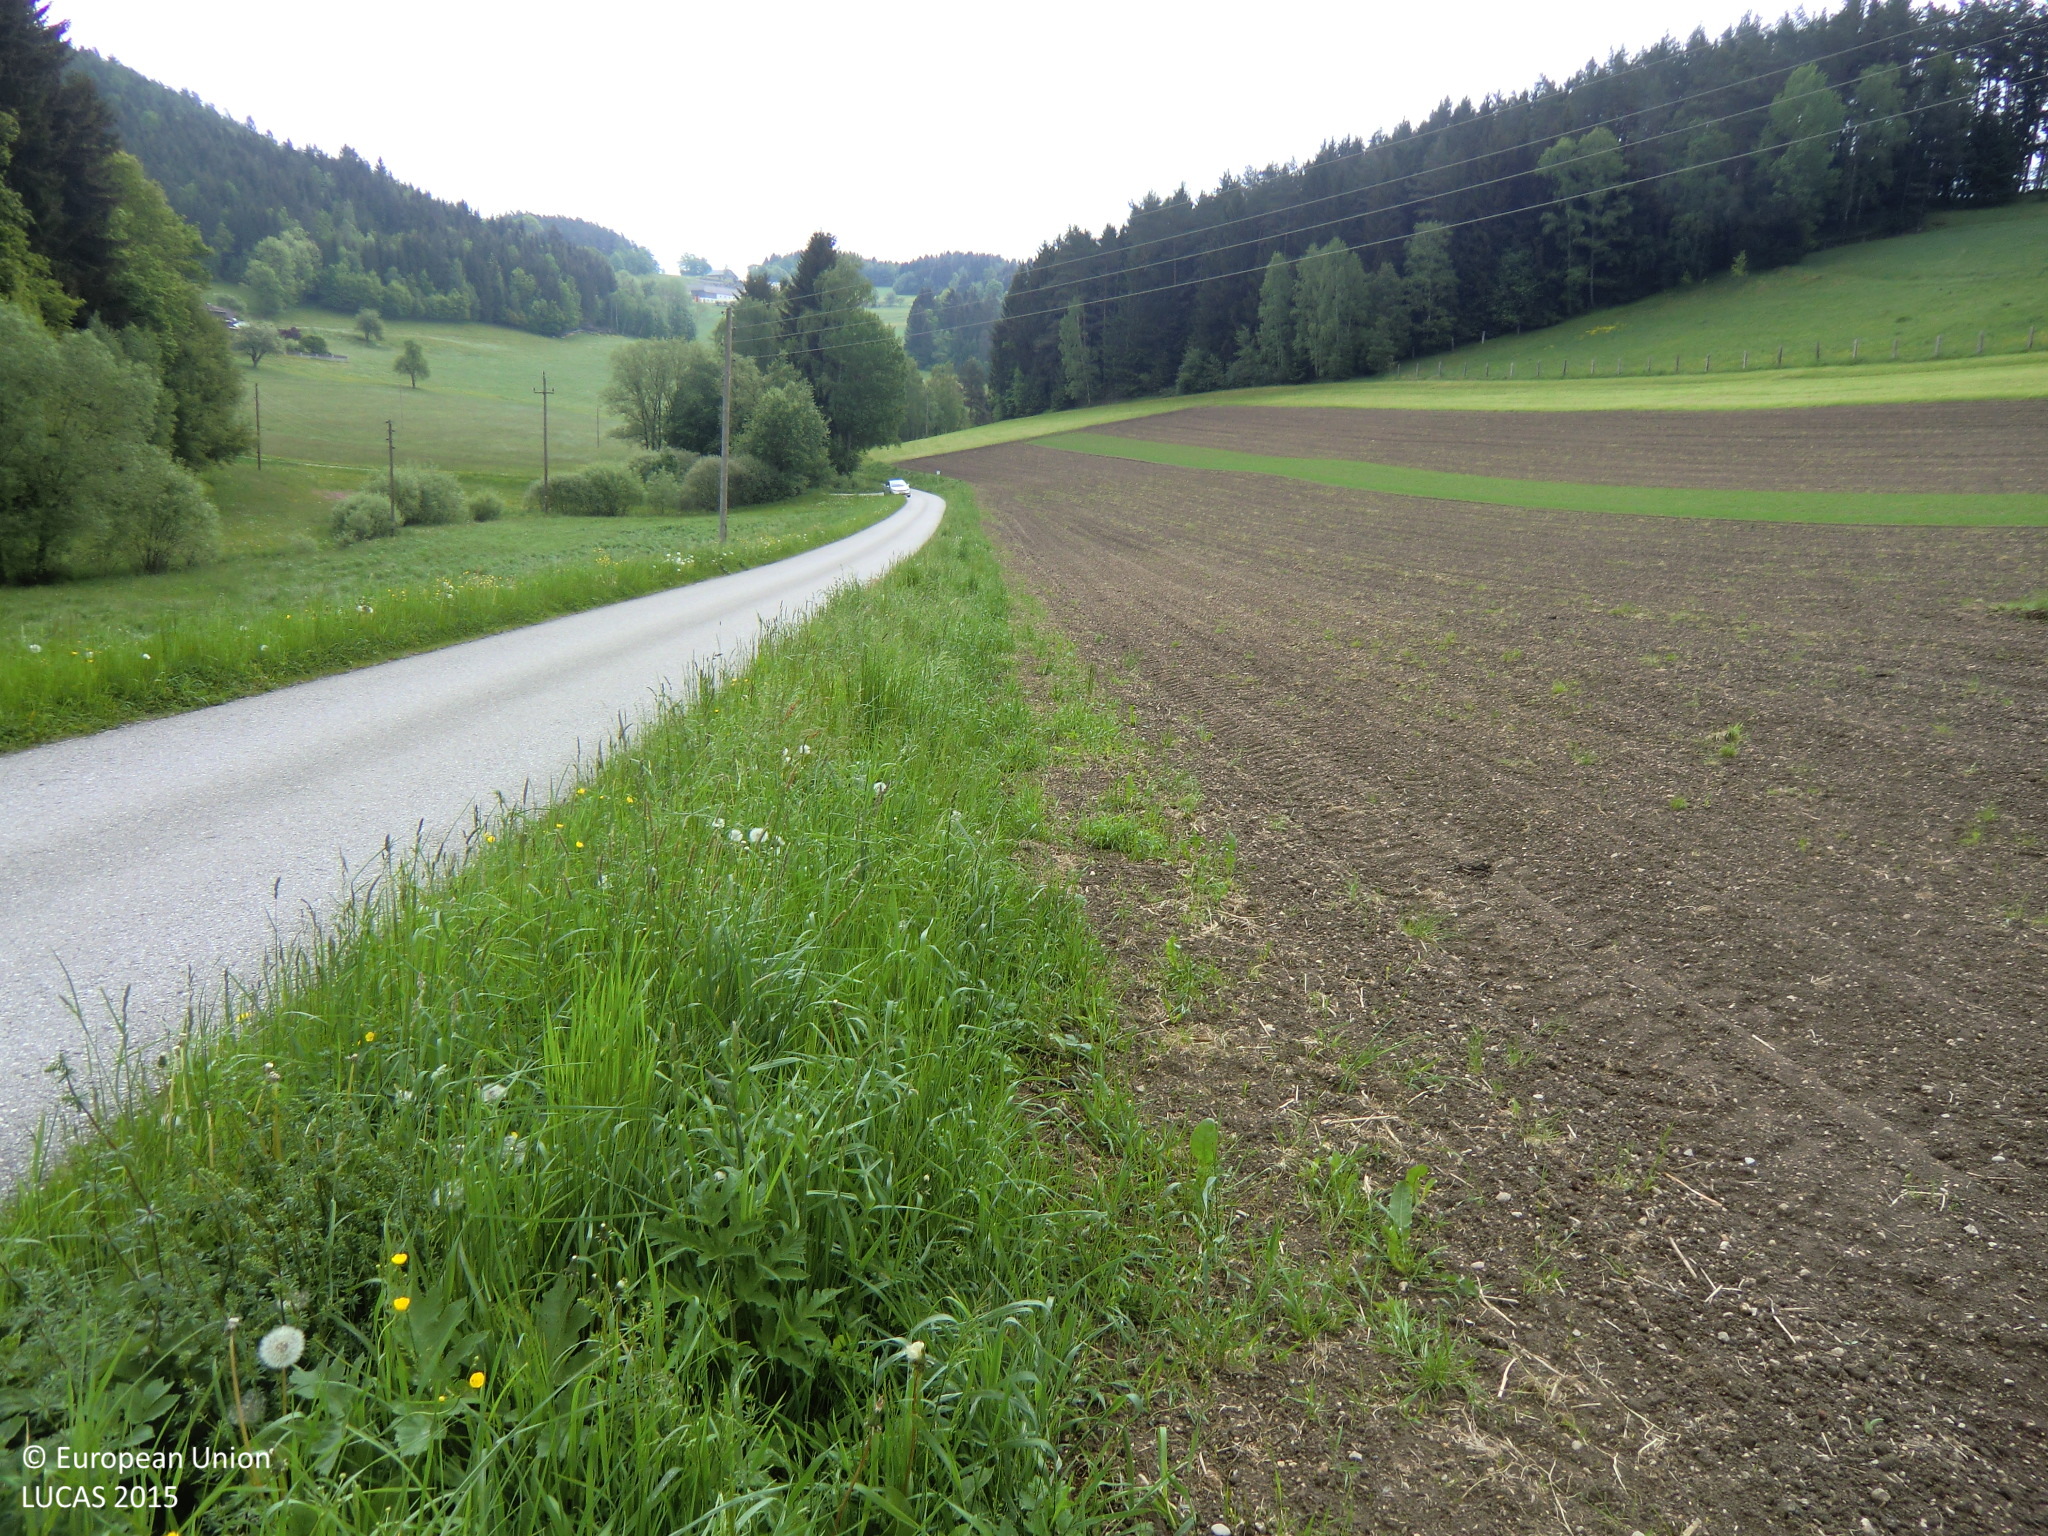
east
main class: Cropland
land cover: Maize
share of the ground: < 10 %
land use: Agriculture (excluding fallow land and kitchen gardens)
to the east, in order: Maize; Grass margins; Paved roads, cycling and walking lanes; Electric lines; Abandoned hedges; Rivers and streams; Grassland without tree/shrub cover; Paved roads, cycling and walking lanes; Grassland without tree/shrub cover
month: May
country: AT
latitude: 48.4761
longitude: 14.4511
